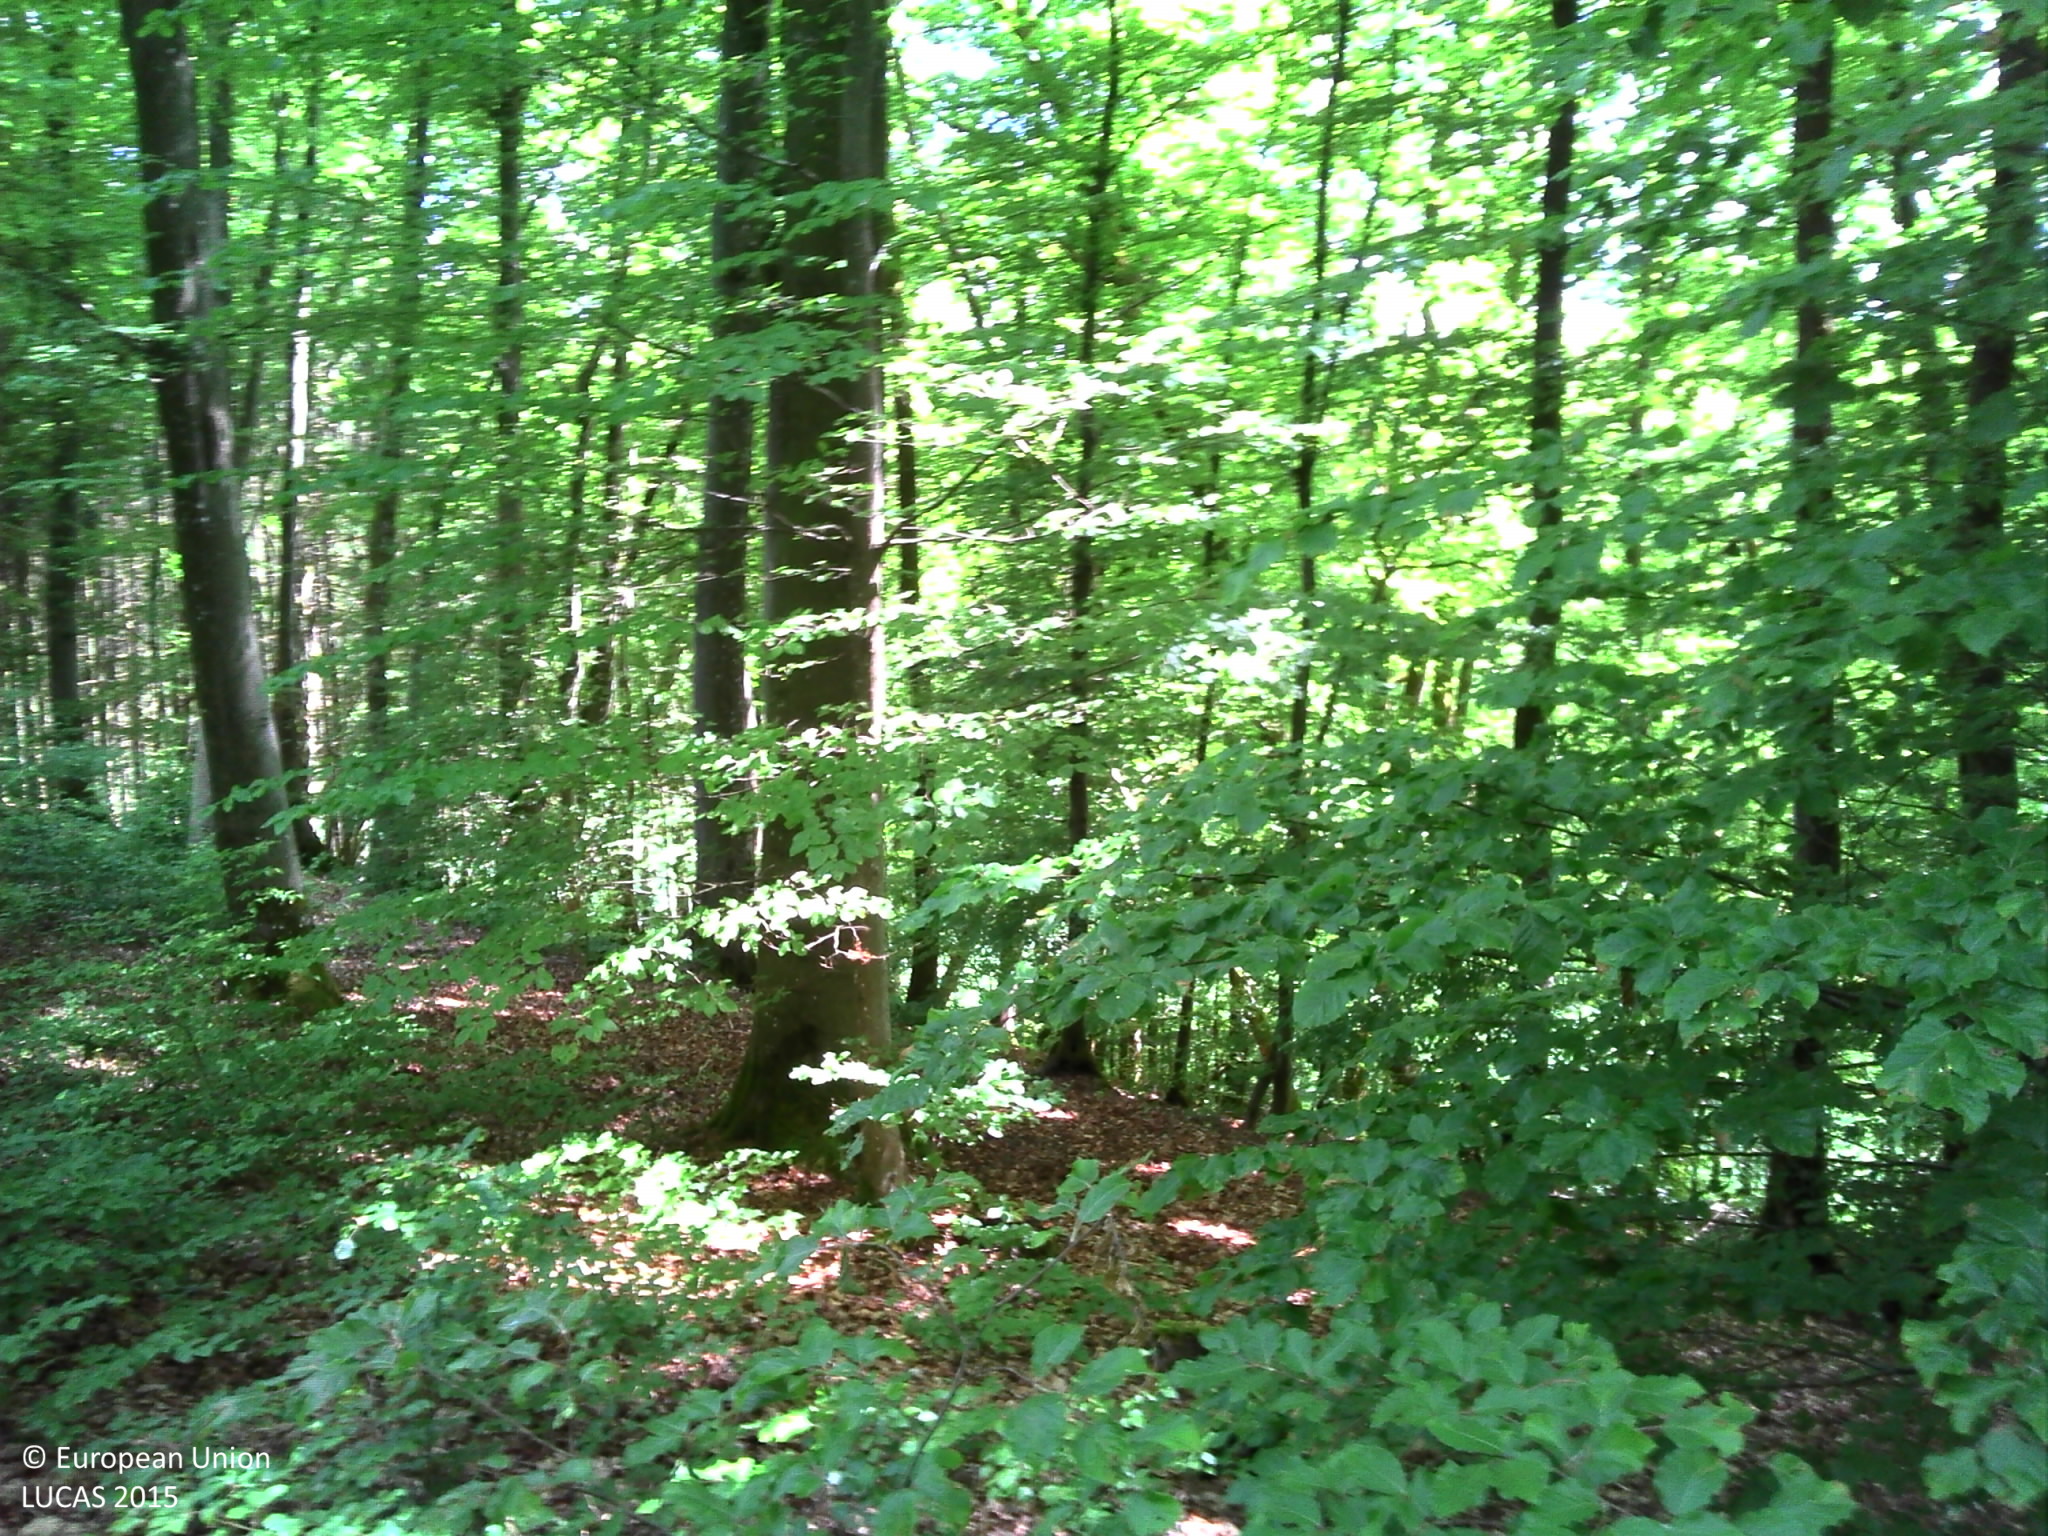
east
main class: Woodland
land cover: Broadleaved woodland
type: acidophilous oak and oak-birch forest
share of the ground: > 75 %
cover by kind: broadleaved forest trees 95 %, coniferous forest trees 5 %
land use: Forestry
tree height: > 5 m
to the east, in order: Broadleaved woodland; Ditches and canals; Broadleaved woodland; Common wheat; Ditches and canals; Lines of trees; Other coniferous woodland; Broadleaved woodland
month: May
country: LU
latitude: 49.6967
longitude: 5.9093
